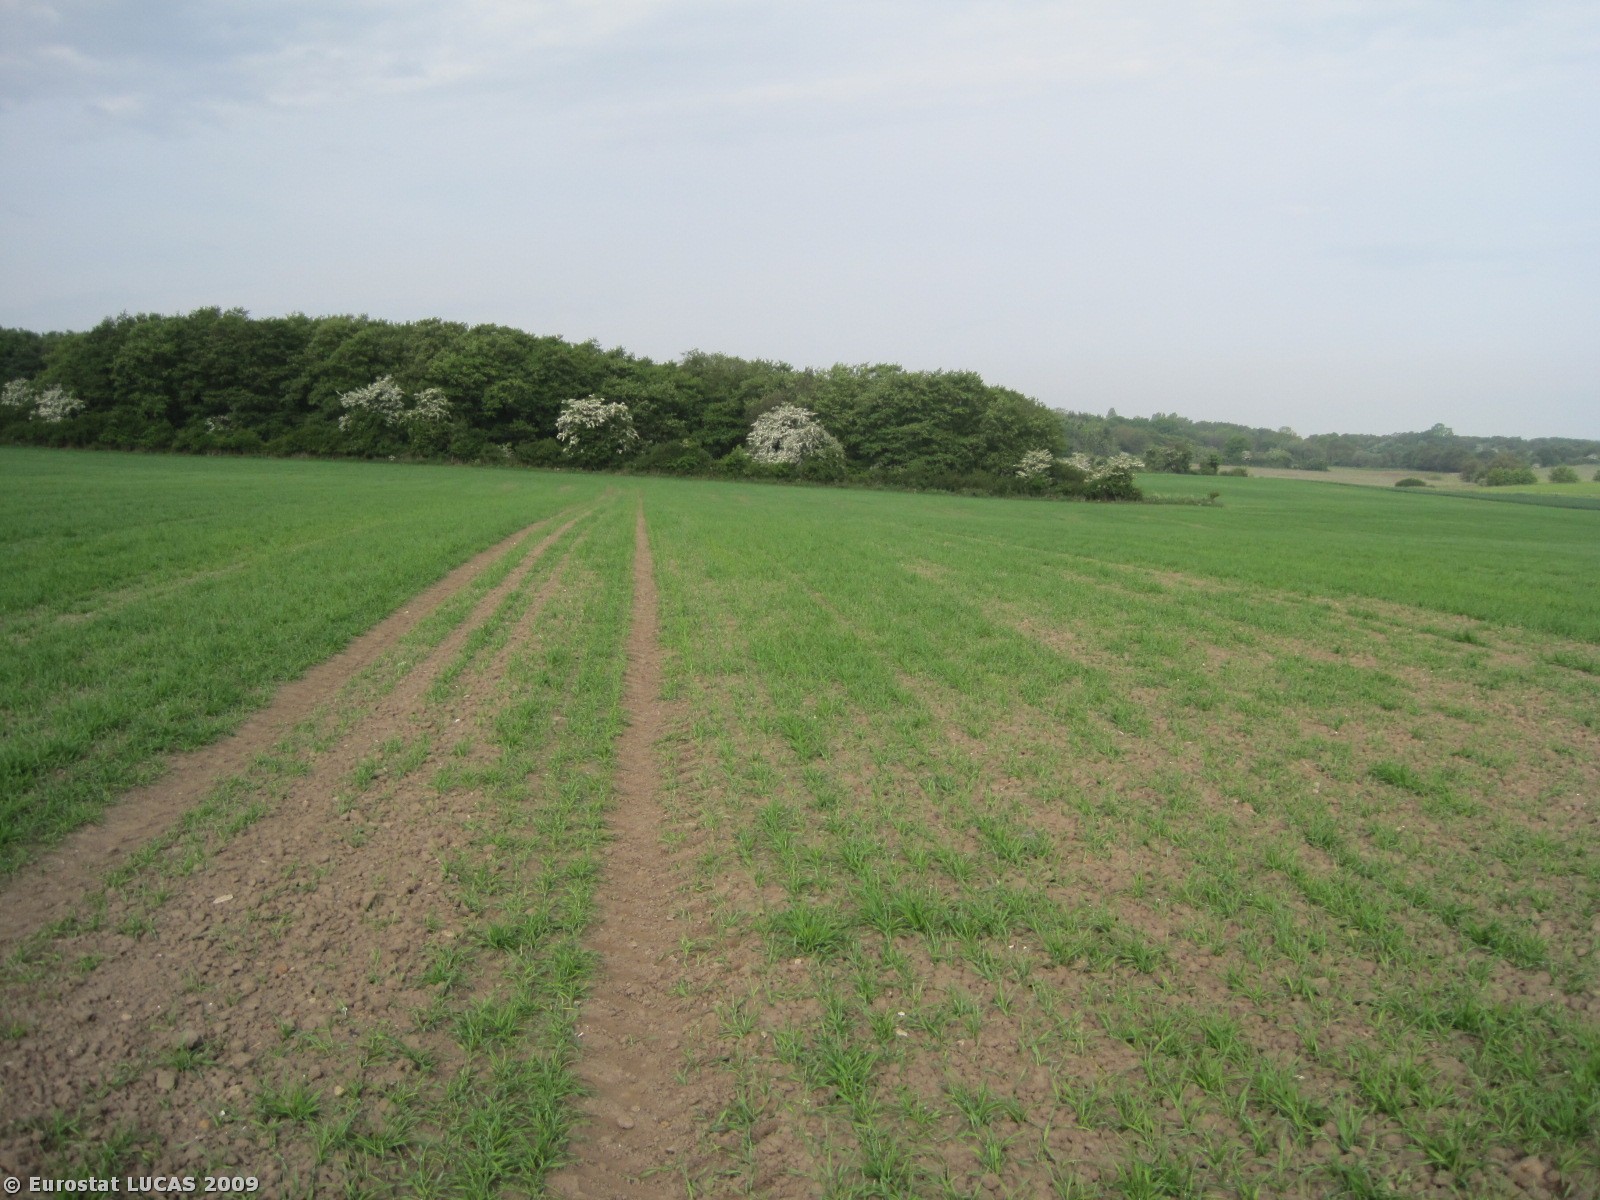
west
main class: Cropland
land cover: Barley
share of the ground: > 75 %
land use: Agriculture (excluding fallow land and kitchen gardens)
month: May
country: DK
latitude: 56.3855
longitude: 10.0162
